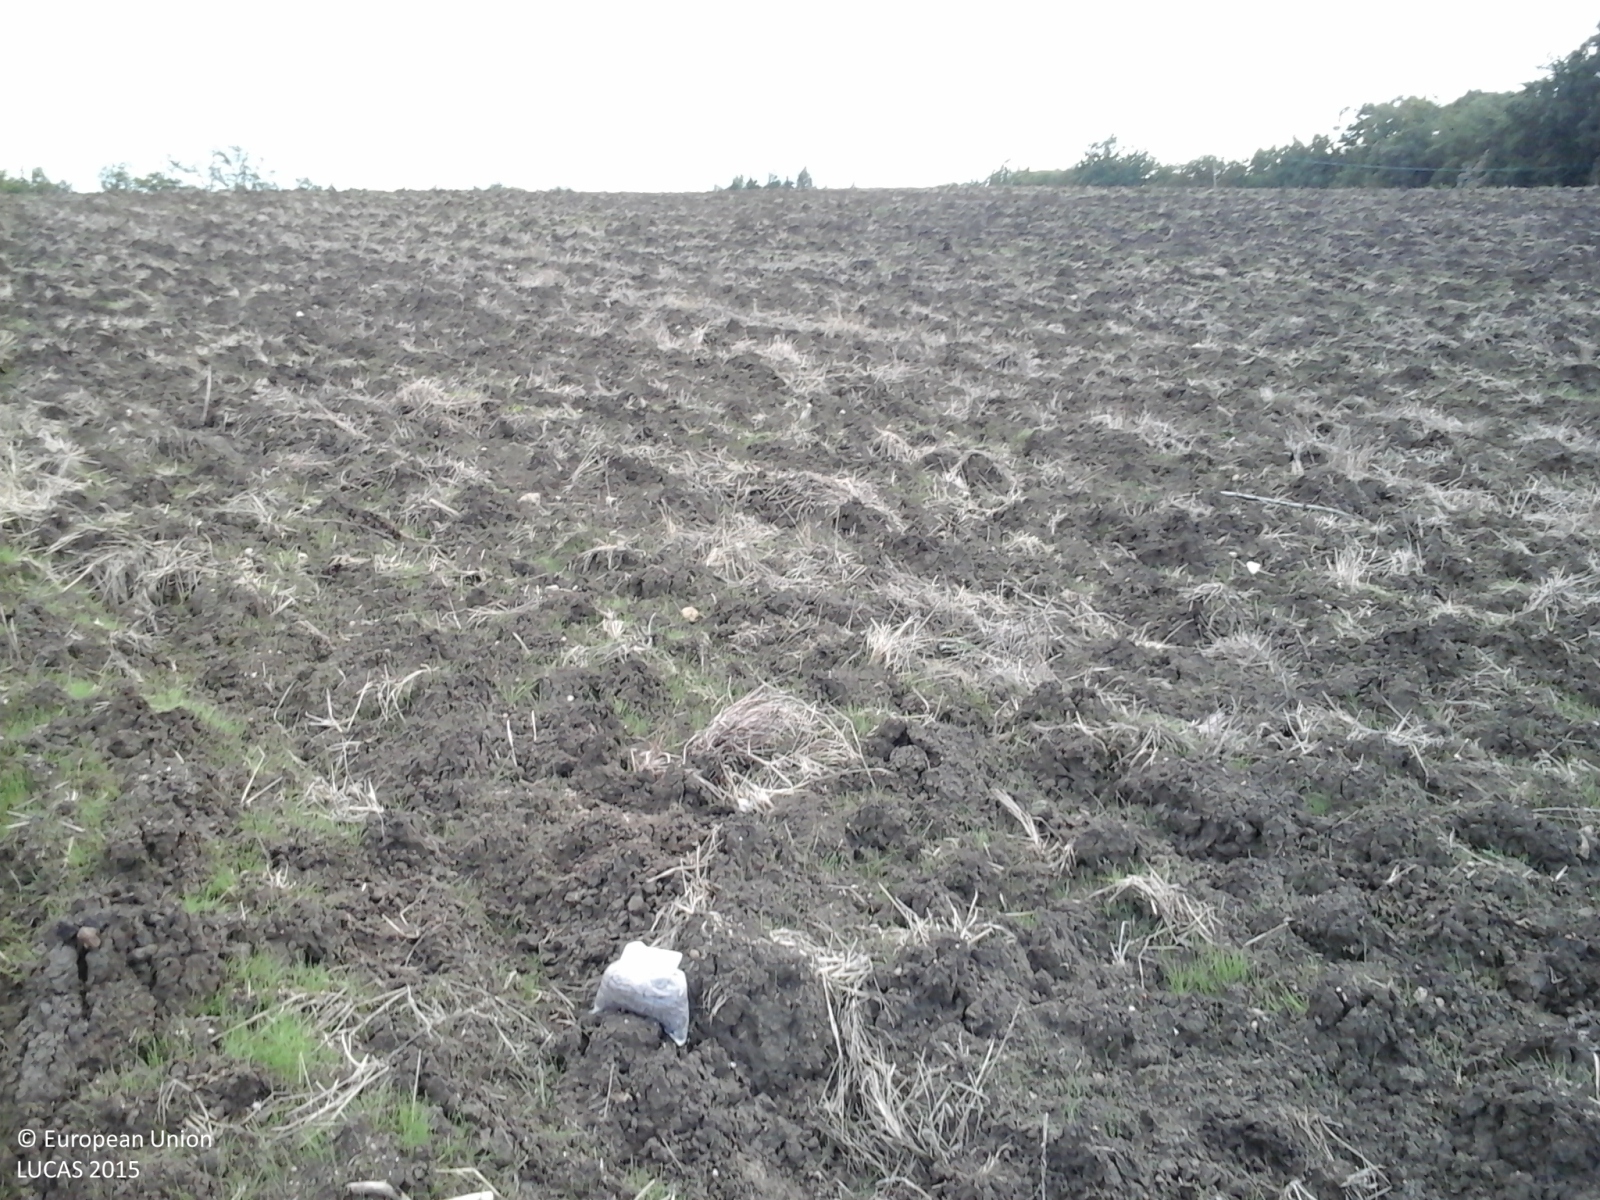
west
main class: Cropland
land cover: Common wheat
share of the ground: < 10 %
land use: Agriculture (excluding fallow land and kitchen gardens)
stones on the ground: 10 - 25 %
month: October
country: IT
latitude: 42.7124
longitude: 12.5439
